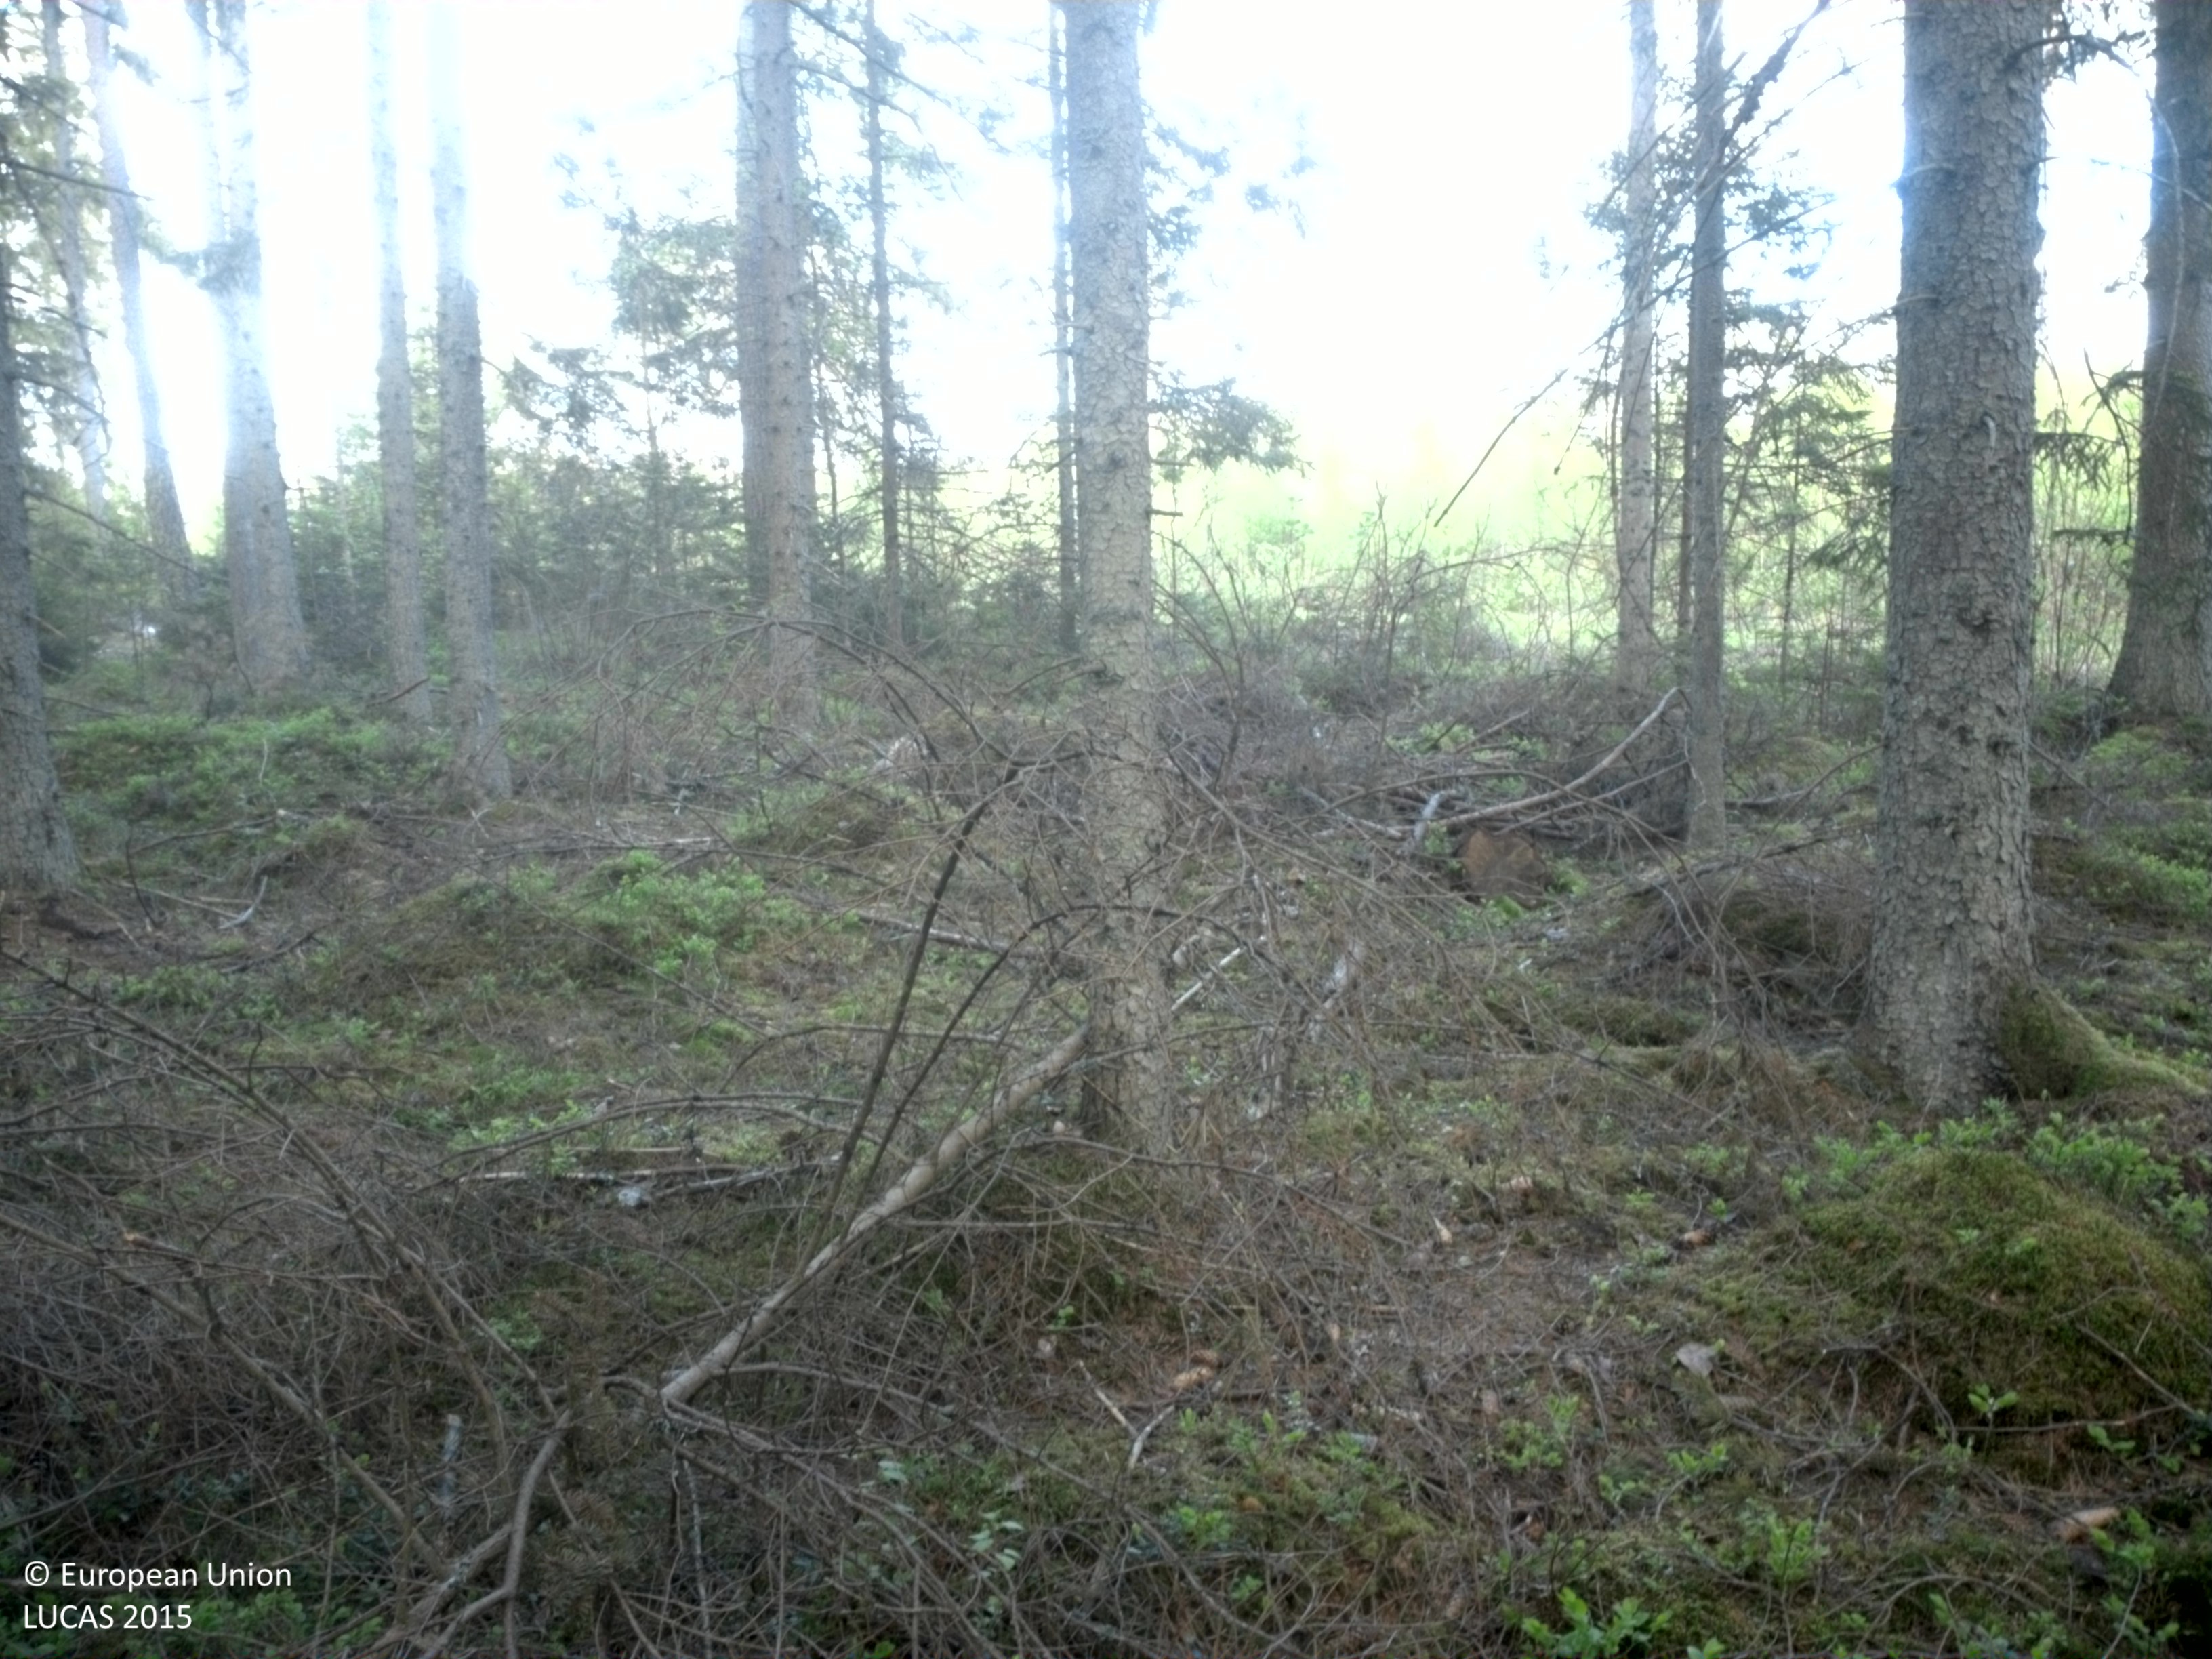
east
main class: Woodland
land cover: Spruce dominated coniferous woodland
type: boreal forest
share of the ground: 50 - 75 %
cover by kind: coniferous forest trees 50 %, shrubs 25 %, lichens and mosses 15 %, herbaceous plants 10 %
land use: Forestry
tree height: > 5 m
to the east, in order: Spruce dominated coniferous woodland; Shrubland with sparse tree cover; Paved roads, cycling and walking lanes; Shrubland without tree cover; Pine dominated coniferous woodland; Spruce dominated mixed woodland
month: May
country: SE
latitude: 56.6039
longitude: 15.2273
